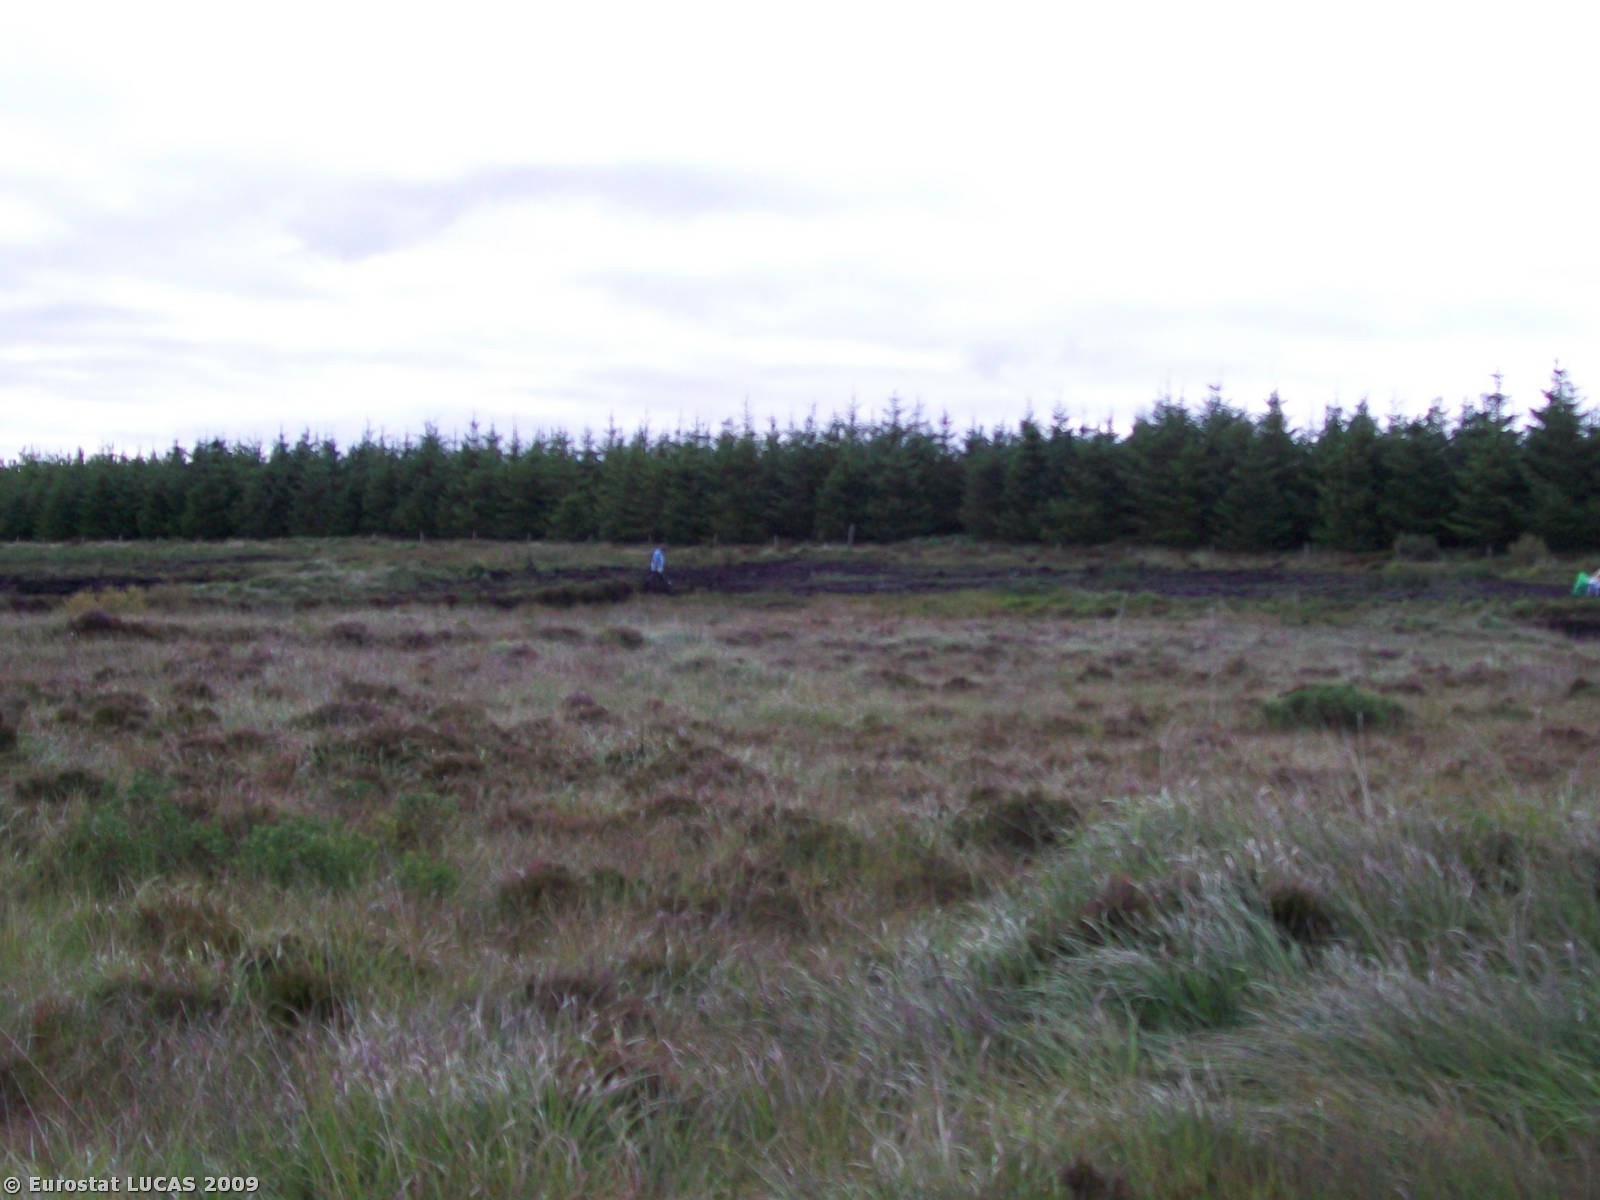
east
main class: Wetlands
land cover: Peatbogs
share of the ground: > 75 %
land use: Mining and quarrying
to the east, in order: Peatbogs; Fences; Coniferous woodland
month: August
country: IE
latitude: 52.7554
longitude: -9.1705
